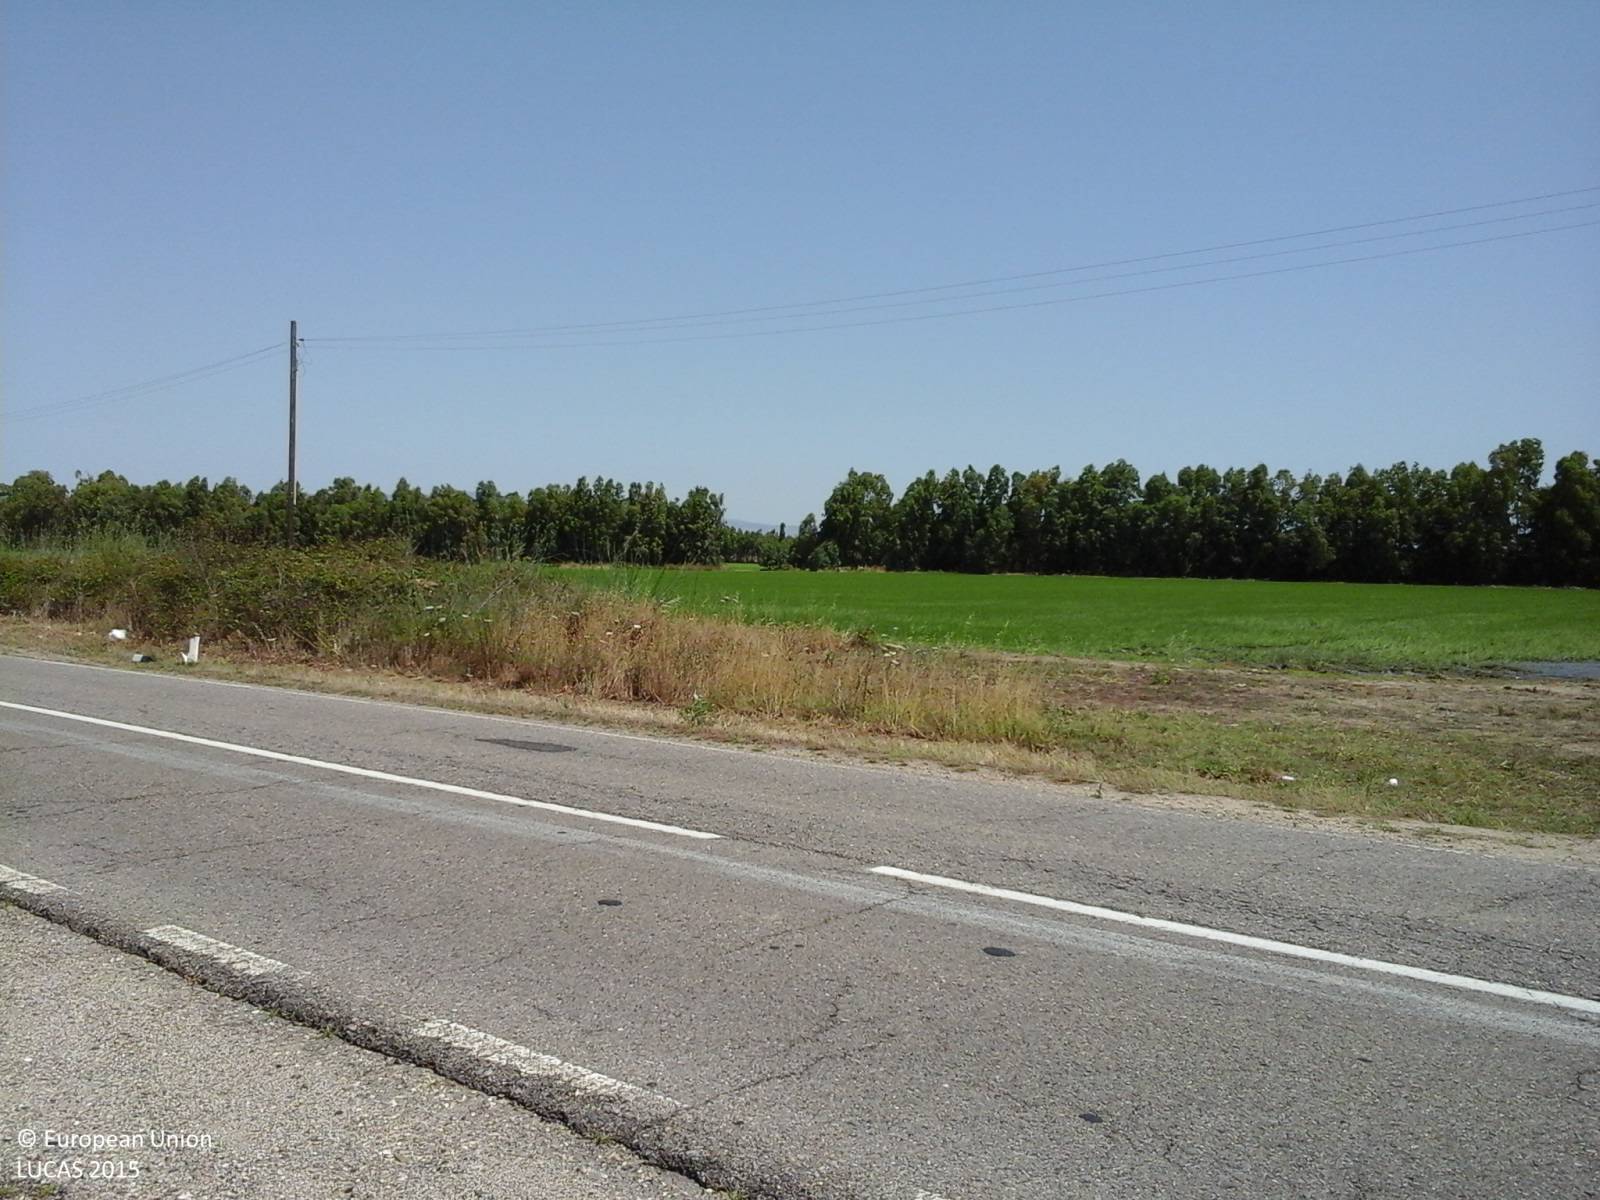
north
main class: Grassland
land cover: Grassland without tree/shrub cover
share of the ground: > 75 %
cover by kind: herbaceous plants 100 %
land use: Air transport
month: June
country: IT
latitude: 39.8957
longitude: 8.6392
